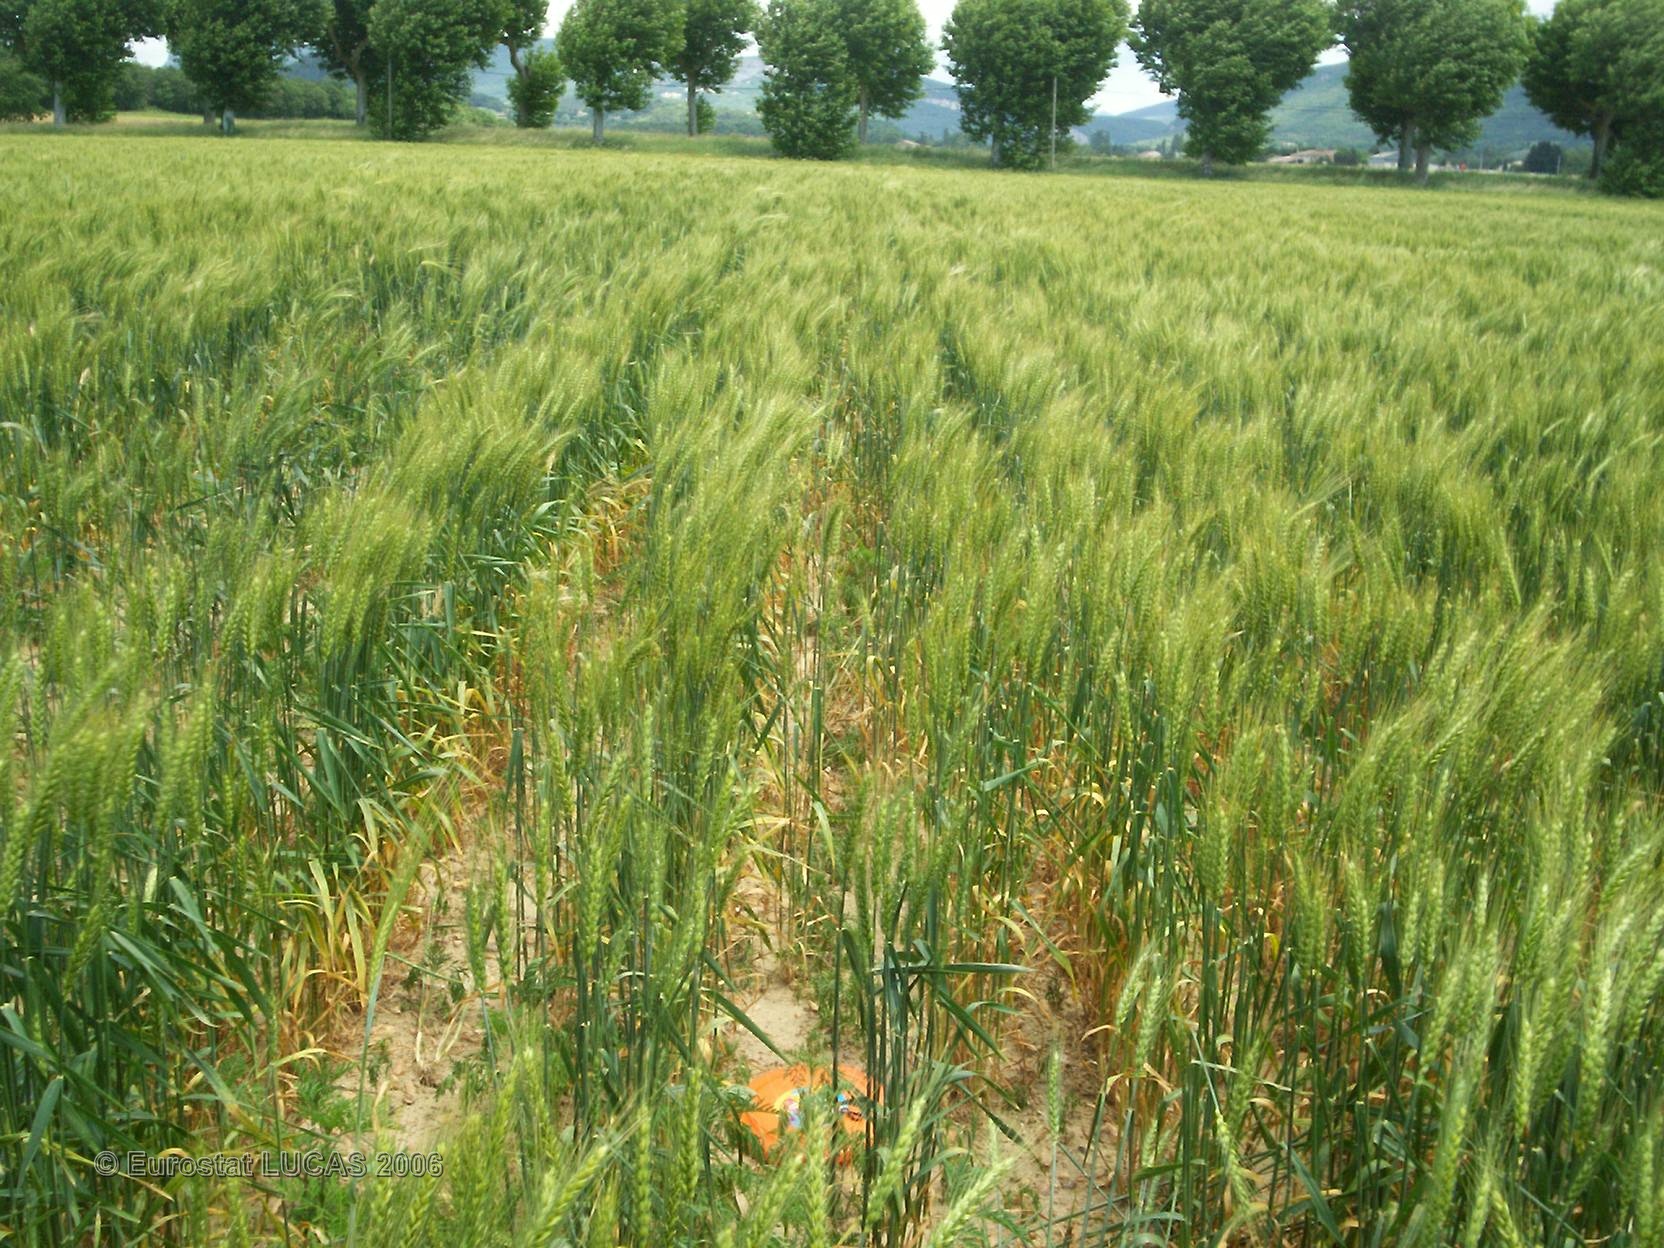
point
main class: Cropland
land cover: Durum wheat
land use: Agriculture (excluding fallow land and kitchen gardens)
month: May
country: FR
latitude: 44.5508
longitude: 4.9087
